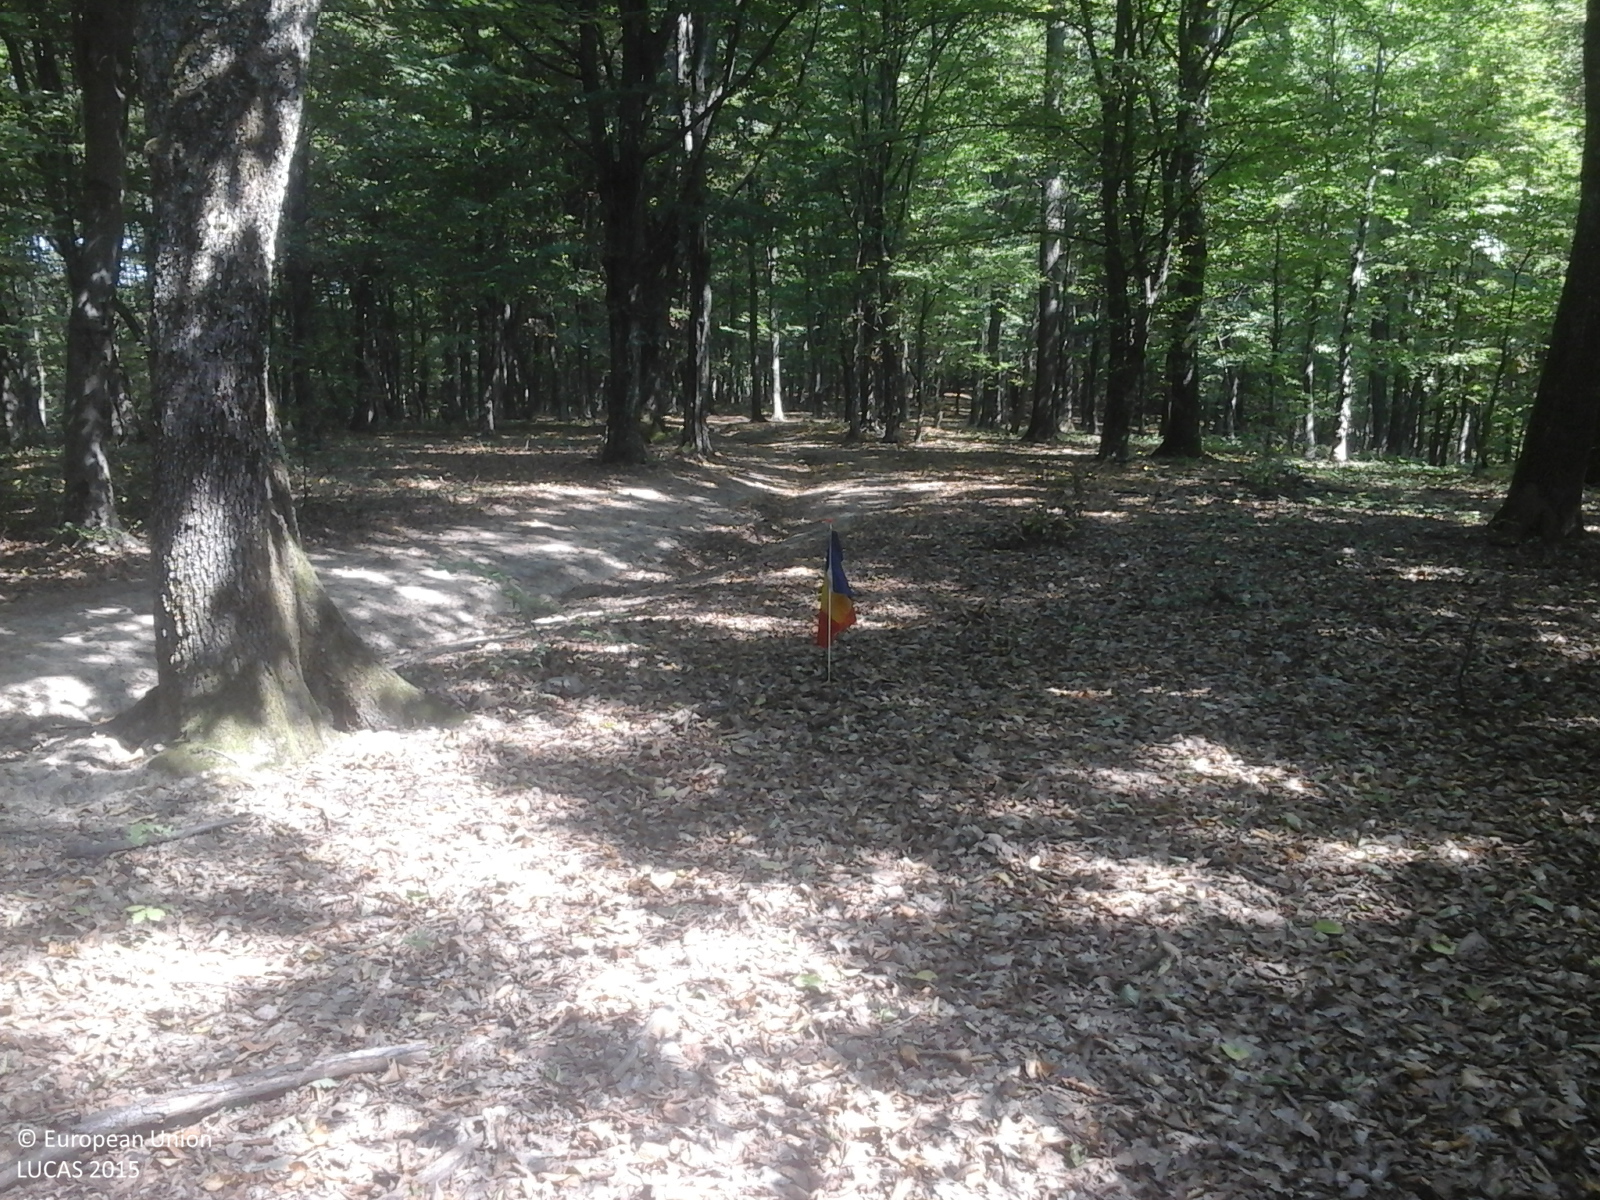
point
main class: Woodland
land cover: Broadleaved woodland
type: mesophytic deciduous forest
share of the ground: > 75 %
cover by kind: broadleaved forest trees 100 %
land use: Forestry
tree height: > 5 m
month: August
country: RO
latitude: 46.4931
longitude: 22.1499
